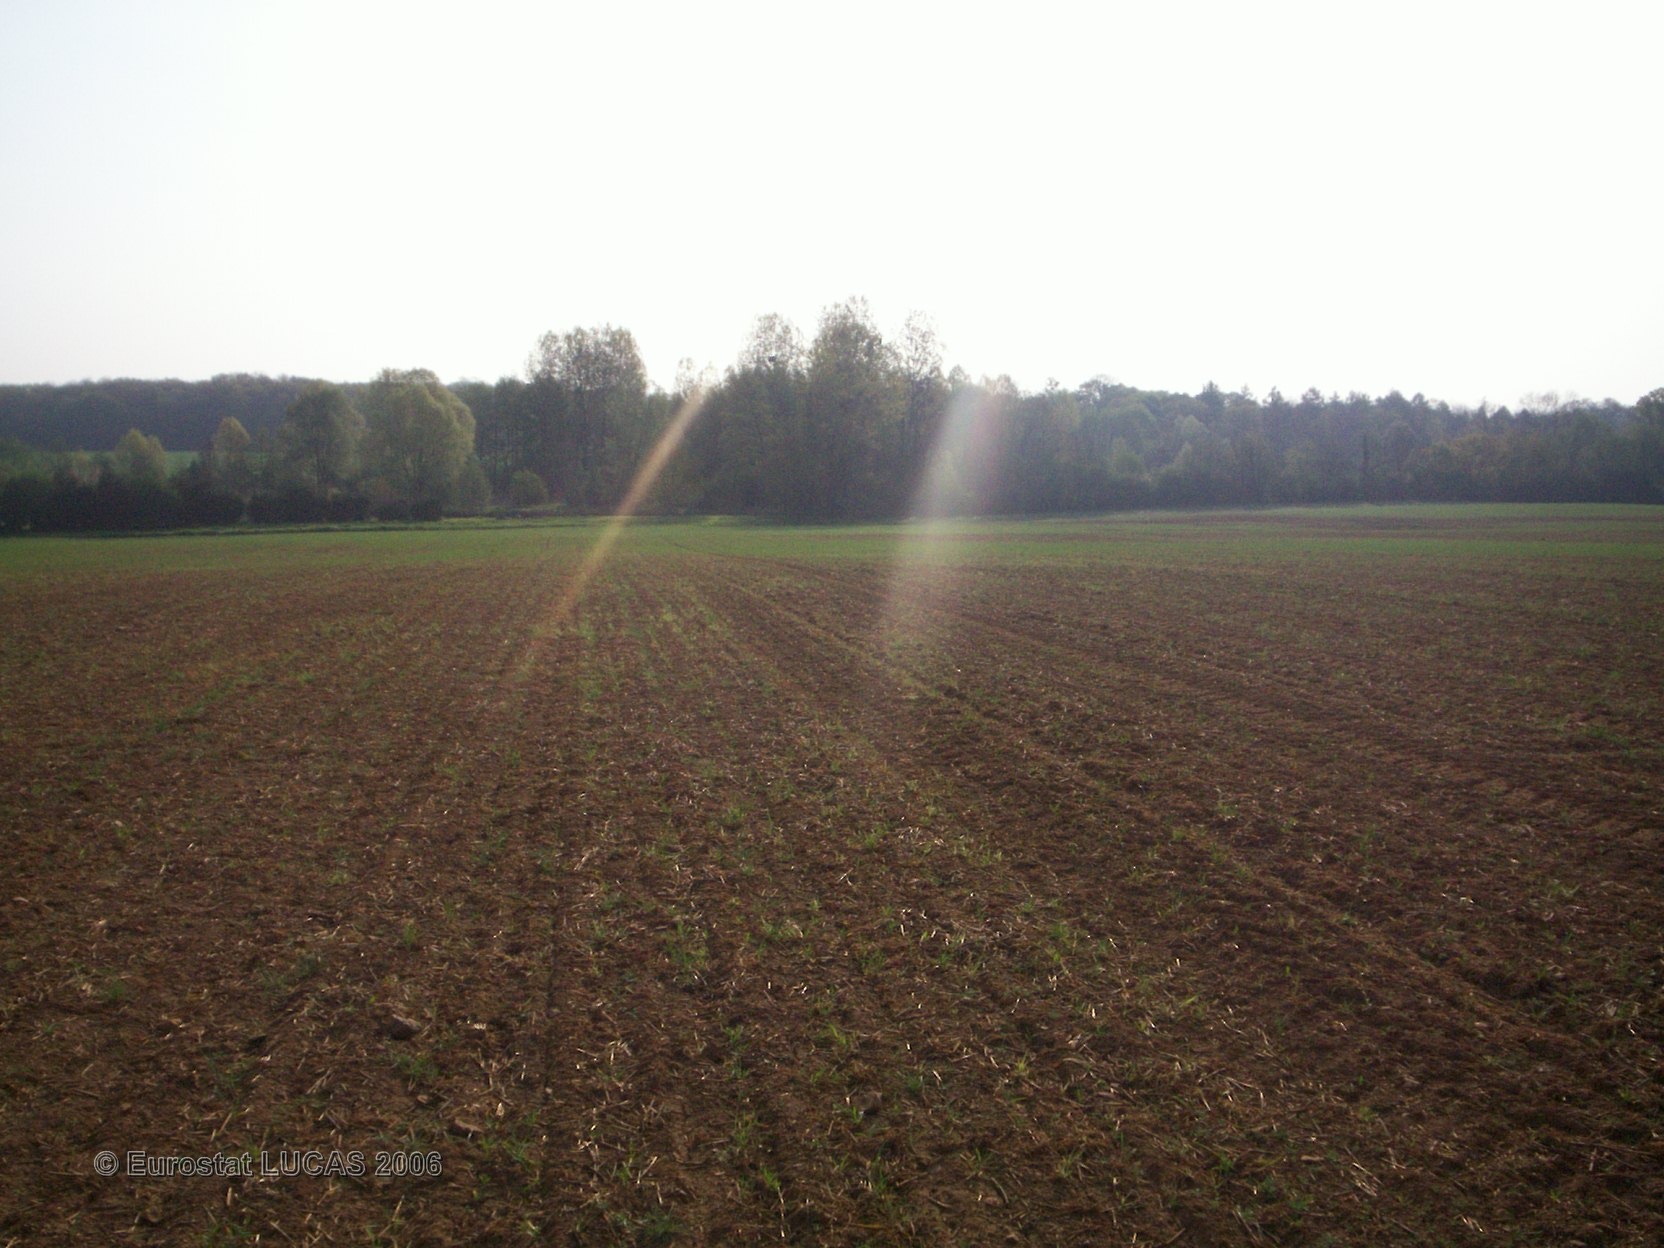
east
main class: Cropland
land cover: Barley
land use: Agriculture (excluding fallow land and kitchen gardens)
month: April
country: FR
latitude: 47.1923
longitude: 3.0662
